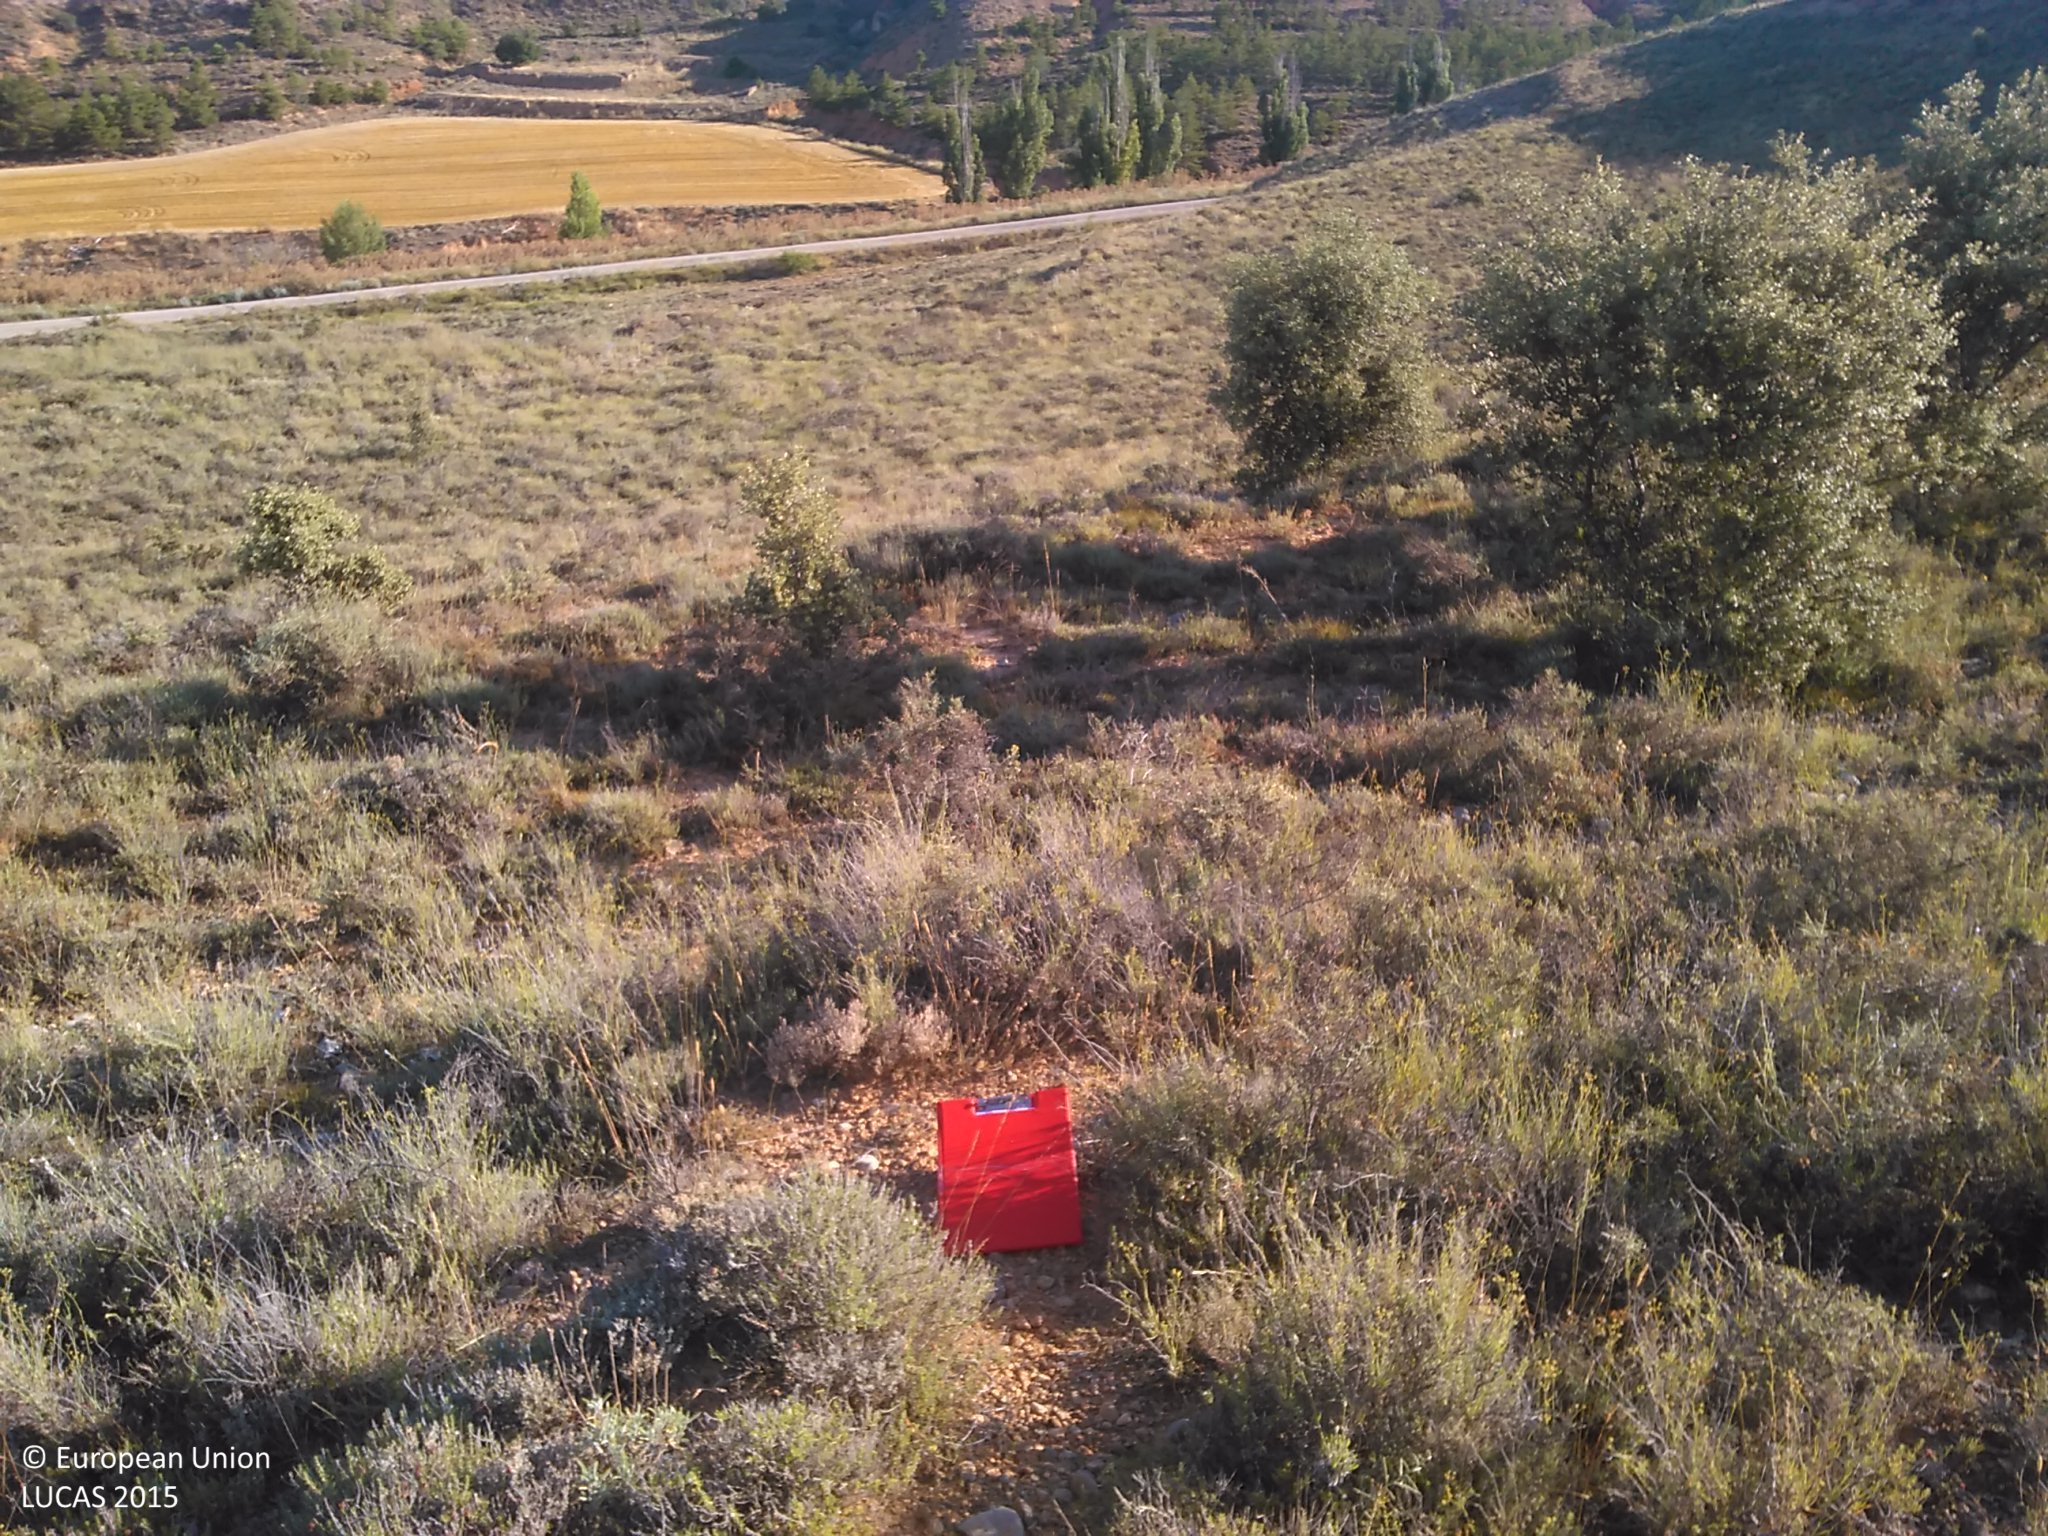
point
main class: Shrubland
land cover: Shrubland without tree cover
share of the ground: 50 - 75 %
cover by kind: shrubs 70 %, unconsolidated bare surface 30 %
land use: Semi-natural and natural areas not in use
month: July
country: ES
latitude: 41.4950
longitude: -2.1903
